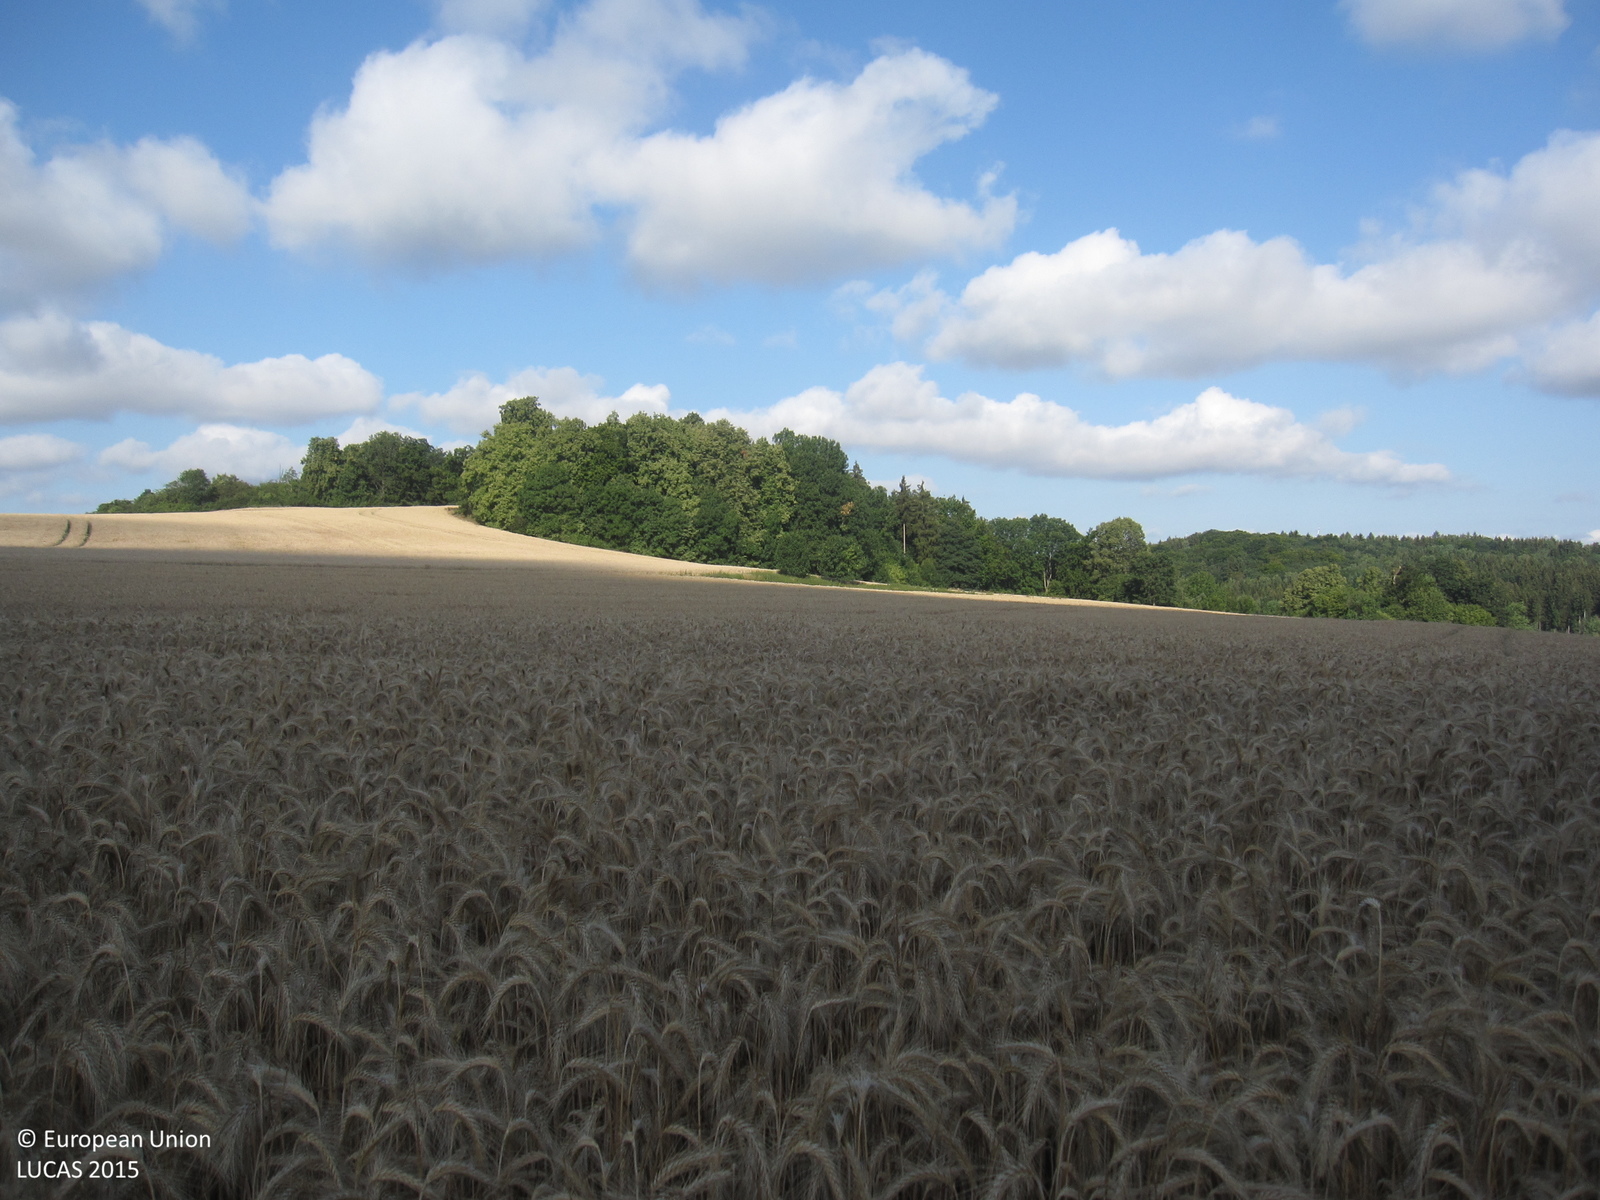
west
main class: Cropland
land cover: Durum wheat
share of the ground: > 75 %
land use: Agriculture (excluding fallow land and kitchen gardens)
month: July
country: DE
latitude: 50.4188
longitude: 11.9841
